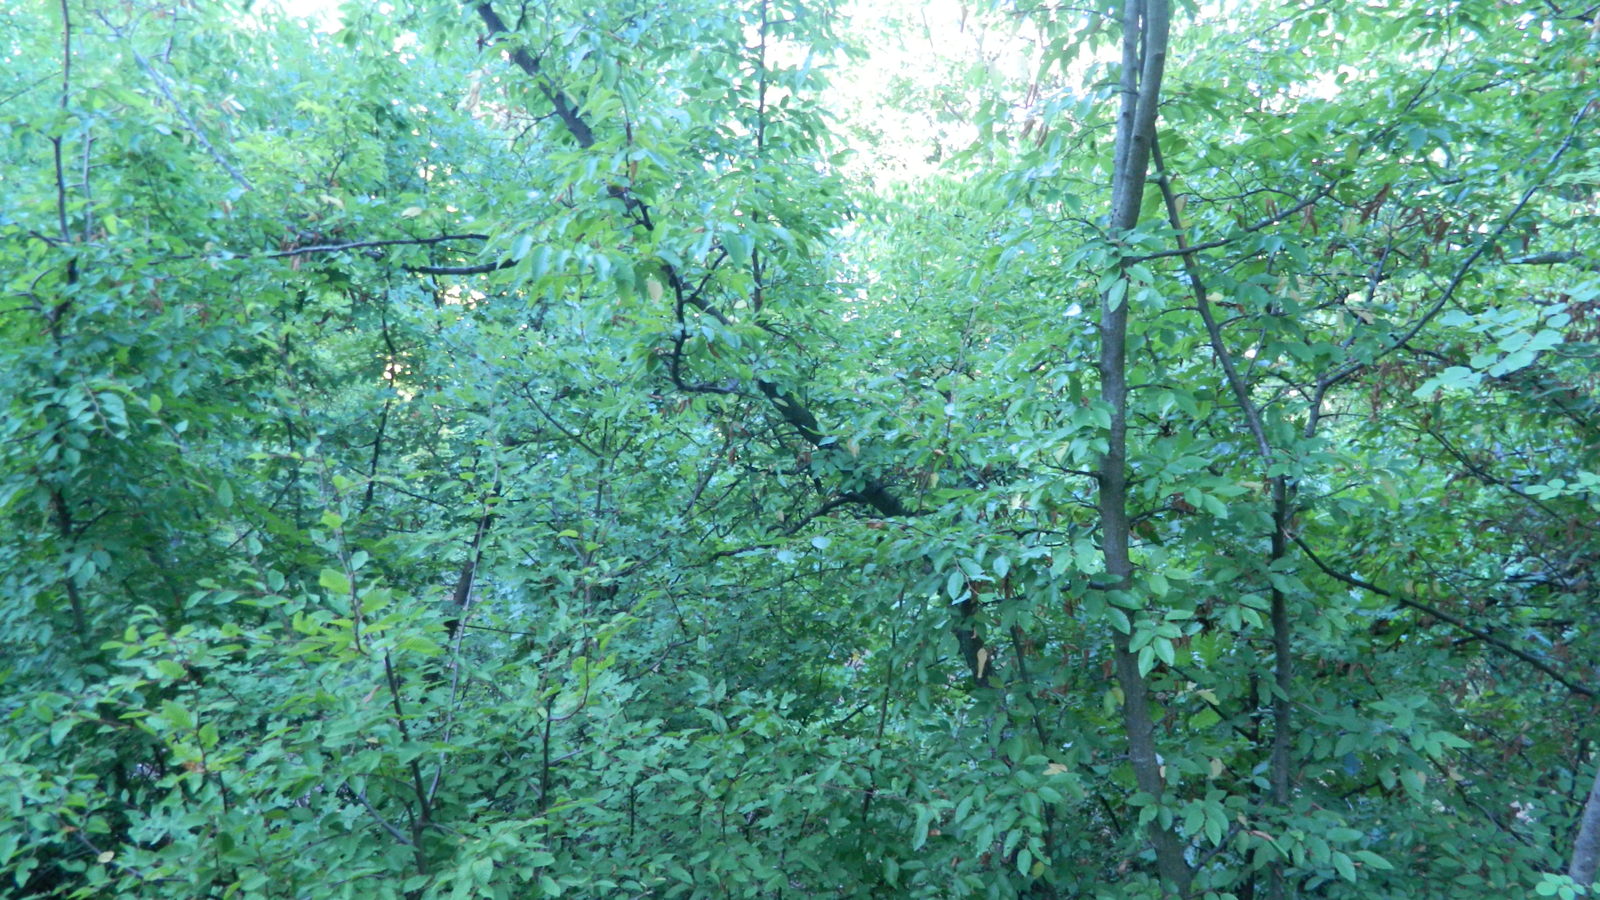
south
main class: Woodland
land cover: Broadleaved woodland
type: mesophytic deciduous forest
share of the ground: > 75 %
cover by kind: broadleaved forest trees 70 %, shrubs 15 %, unconsolidated bare surface 10 %, herbaceous plants 5 %
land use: Forestry
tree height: > 5 m
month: August
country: BG
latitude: 41.6490
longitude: 25.8805
